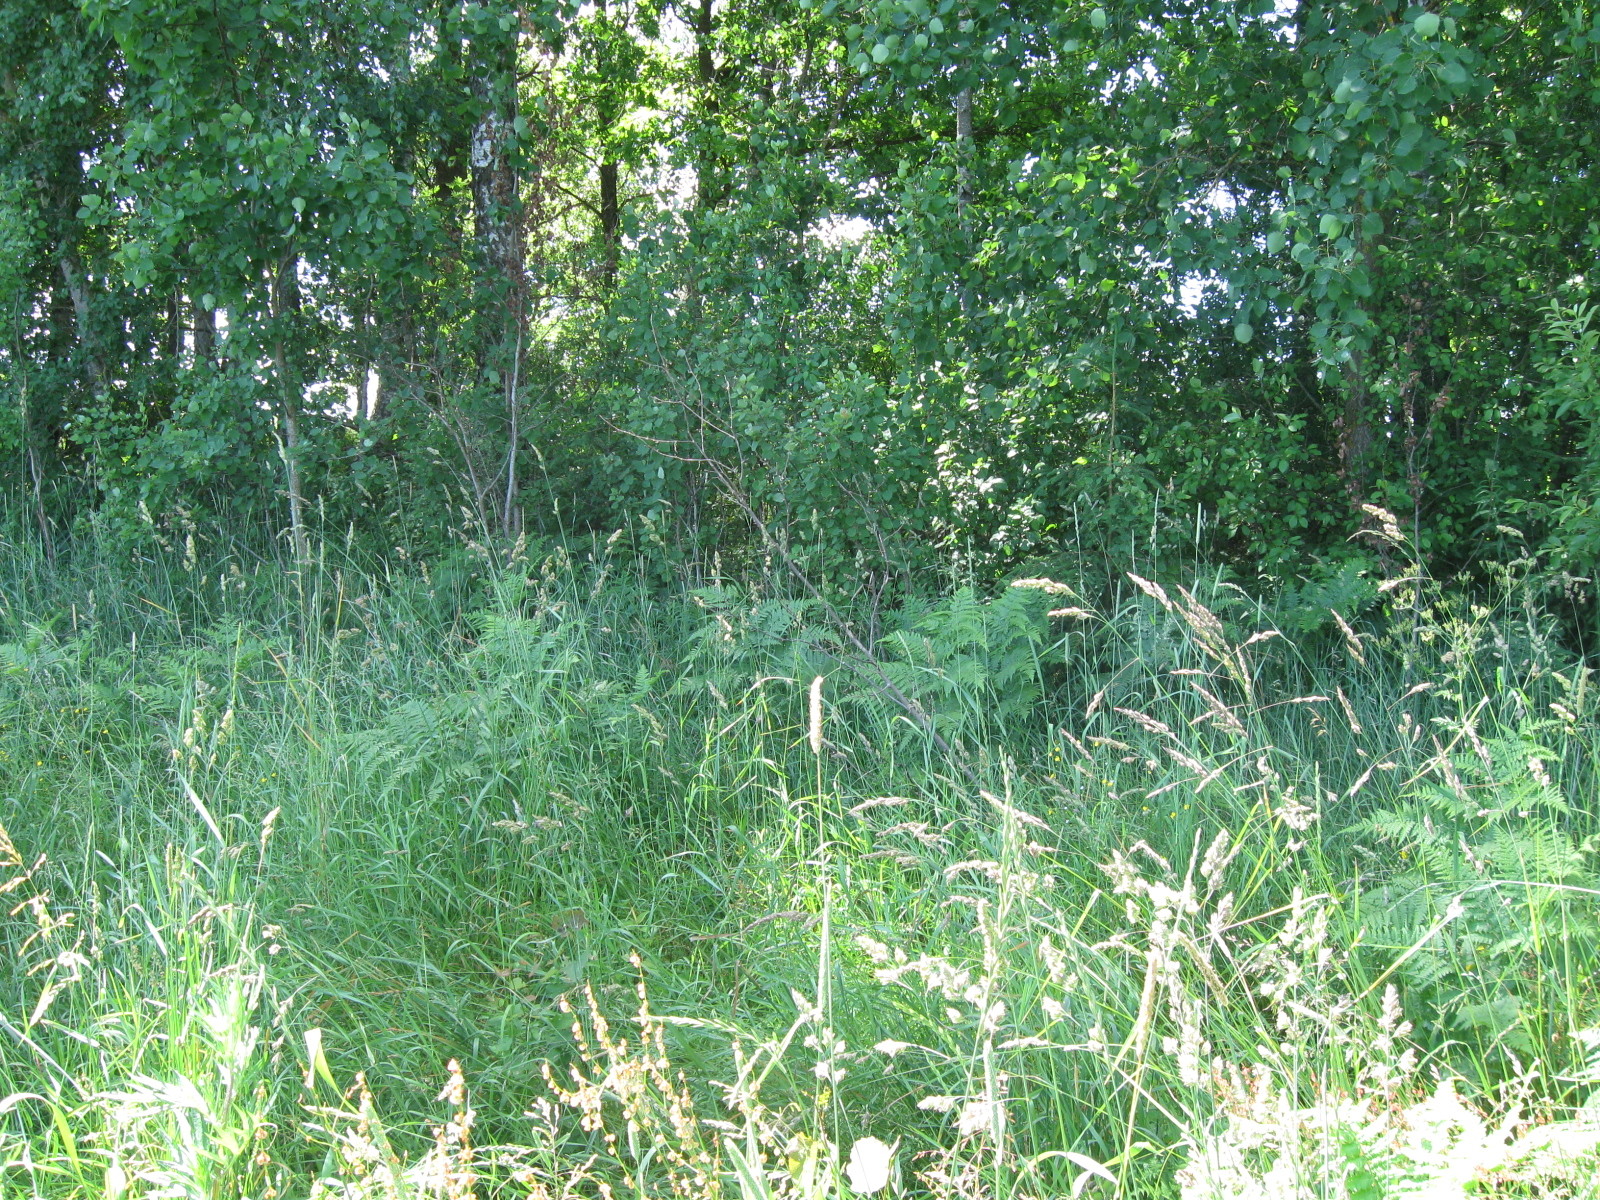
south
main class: Grassland
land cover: Spontaneously vegetated surfaces
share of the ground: > 75 %
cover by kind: herbaceous plants 100 %
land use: Abandoned areas
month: June
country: LT
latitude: 53.9798
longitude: 24.7013
